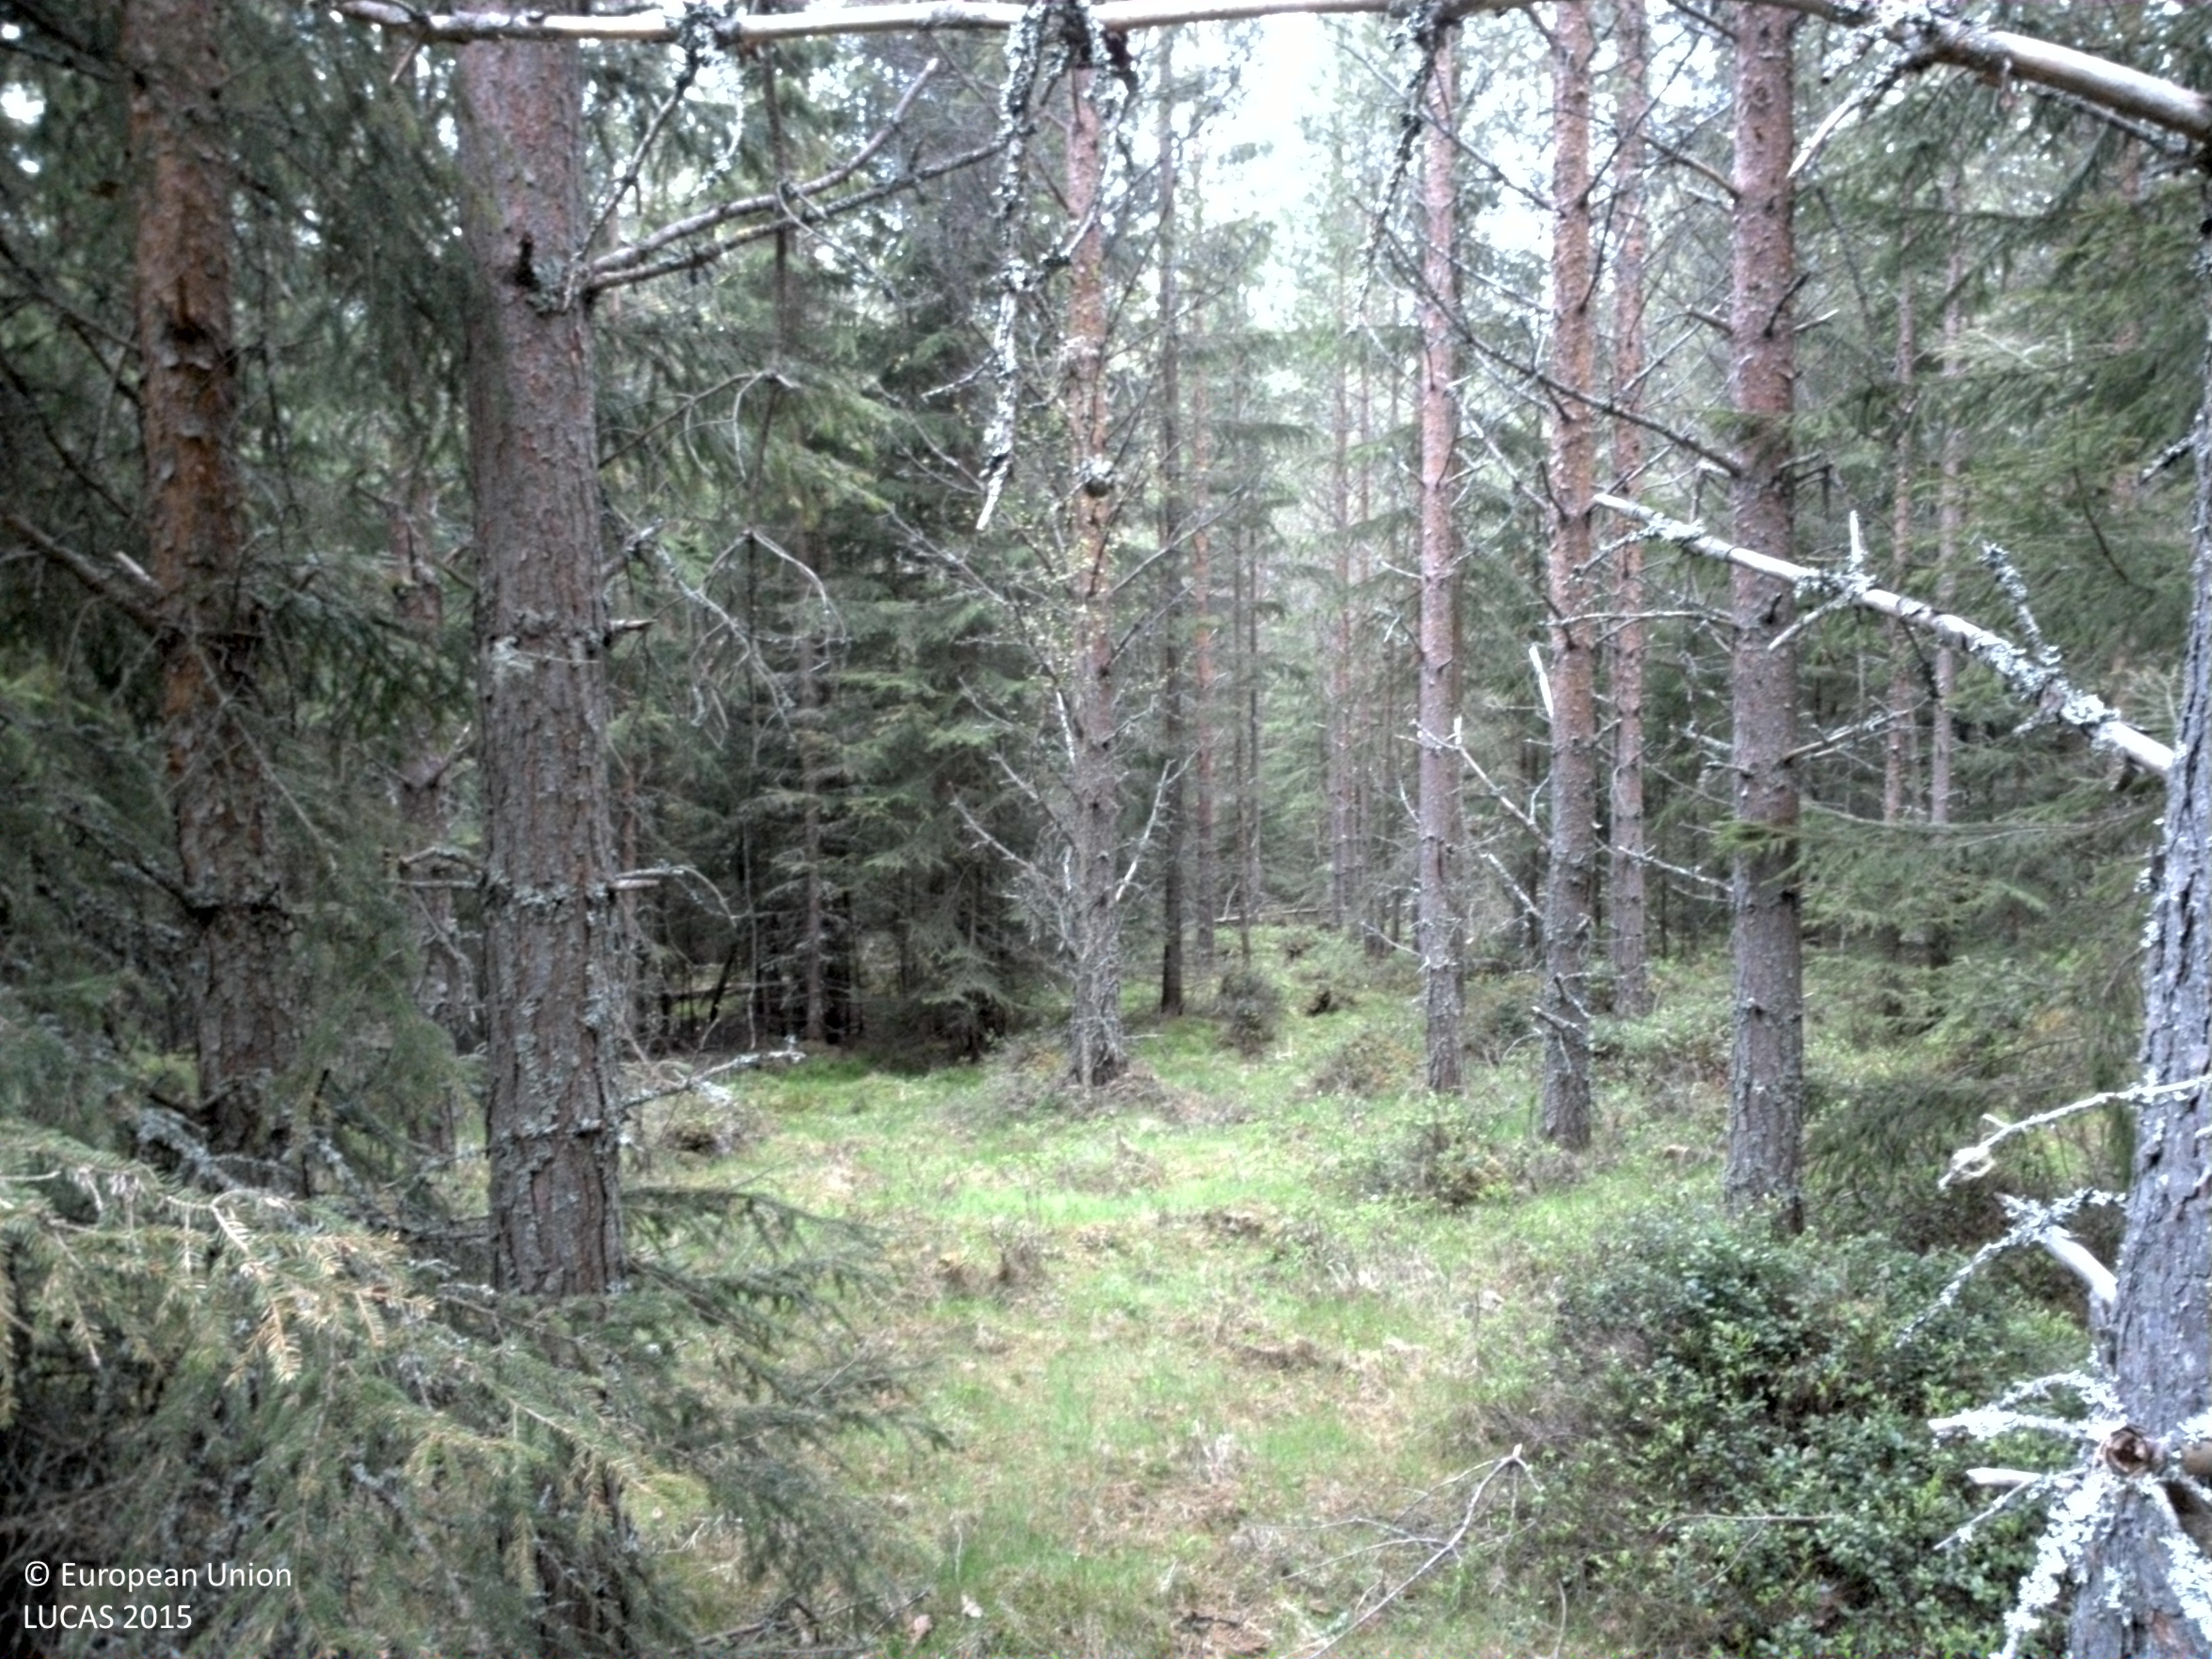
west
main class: Woodland
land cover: Pine dominated coniferous woodland
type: boreal forest
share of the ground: 25 - 50 %
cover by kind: herbaceous plants 65 %, coniferous forest trees 35 %
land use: Forestry
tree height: > 5 m
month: May
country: SE
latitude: 61.1801
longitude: 15.3595
